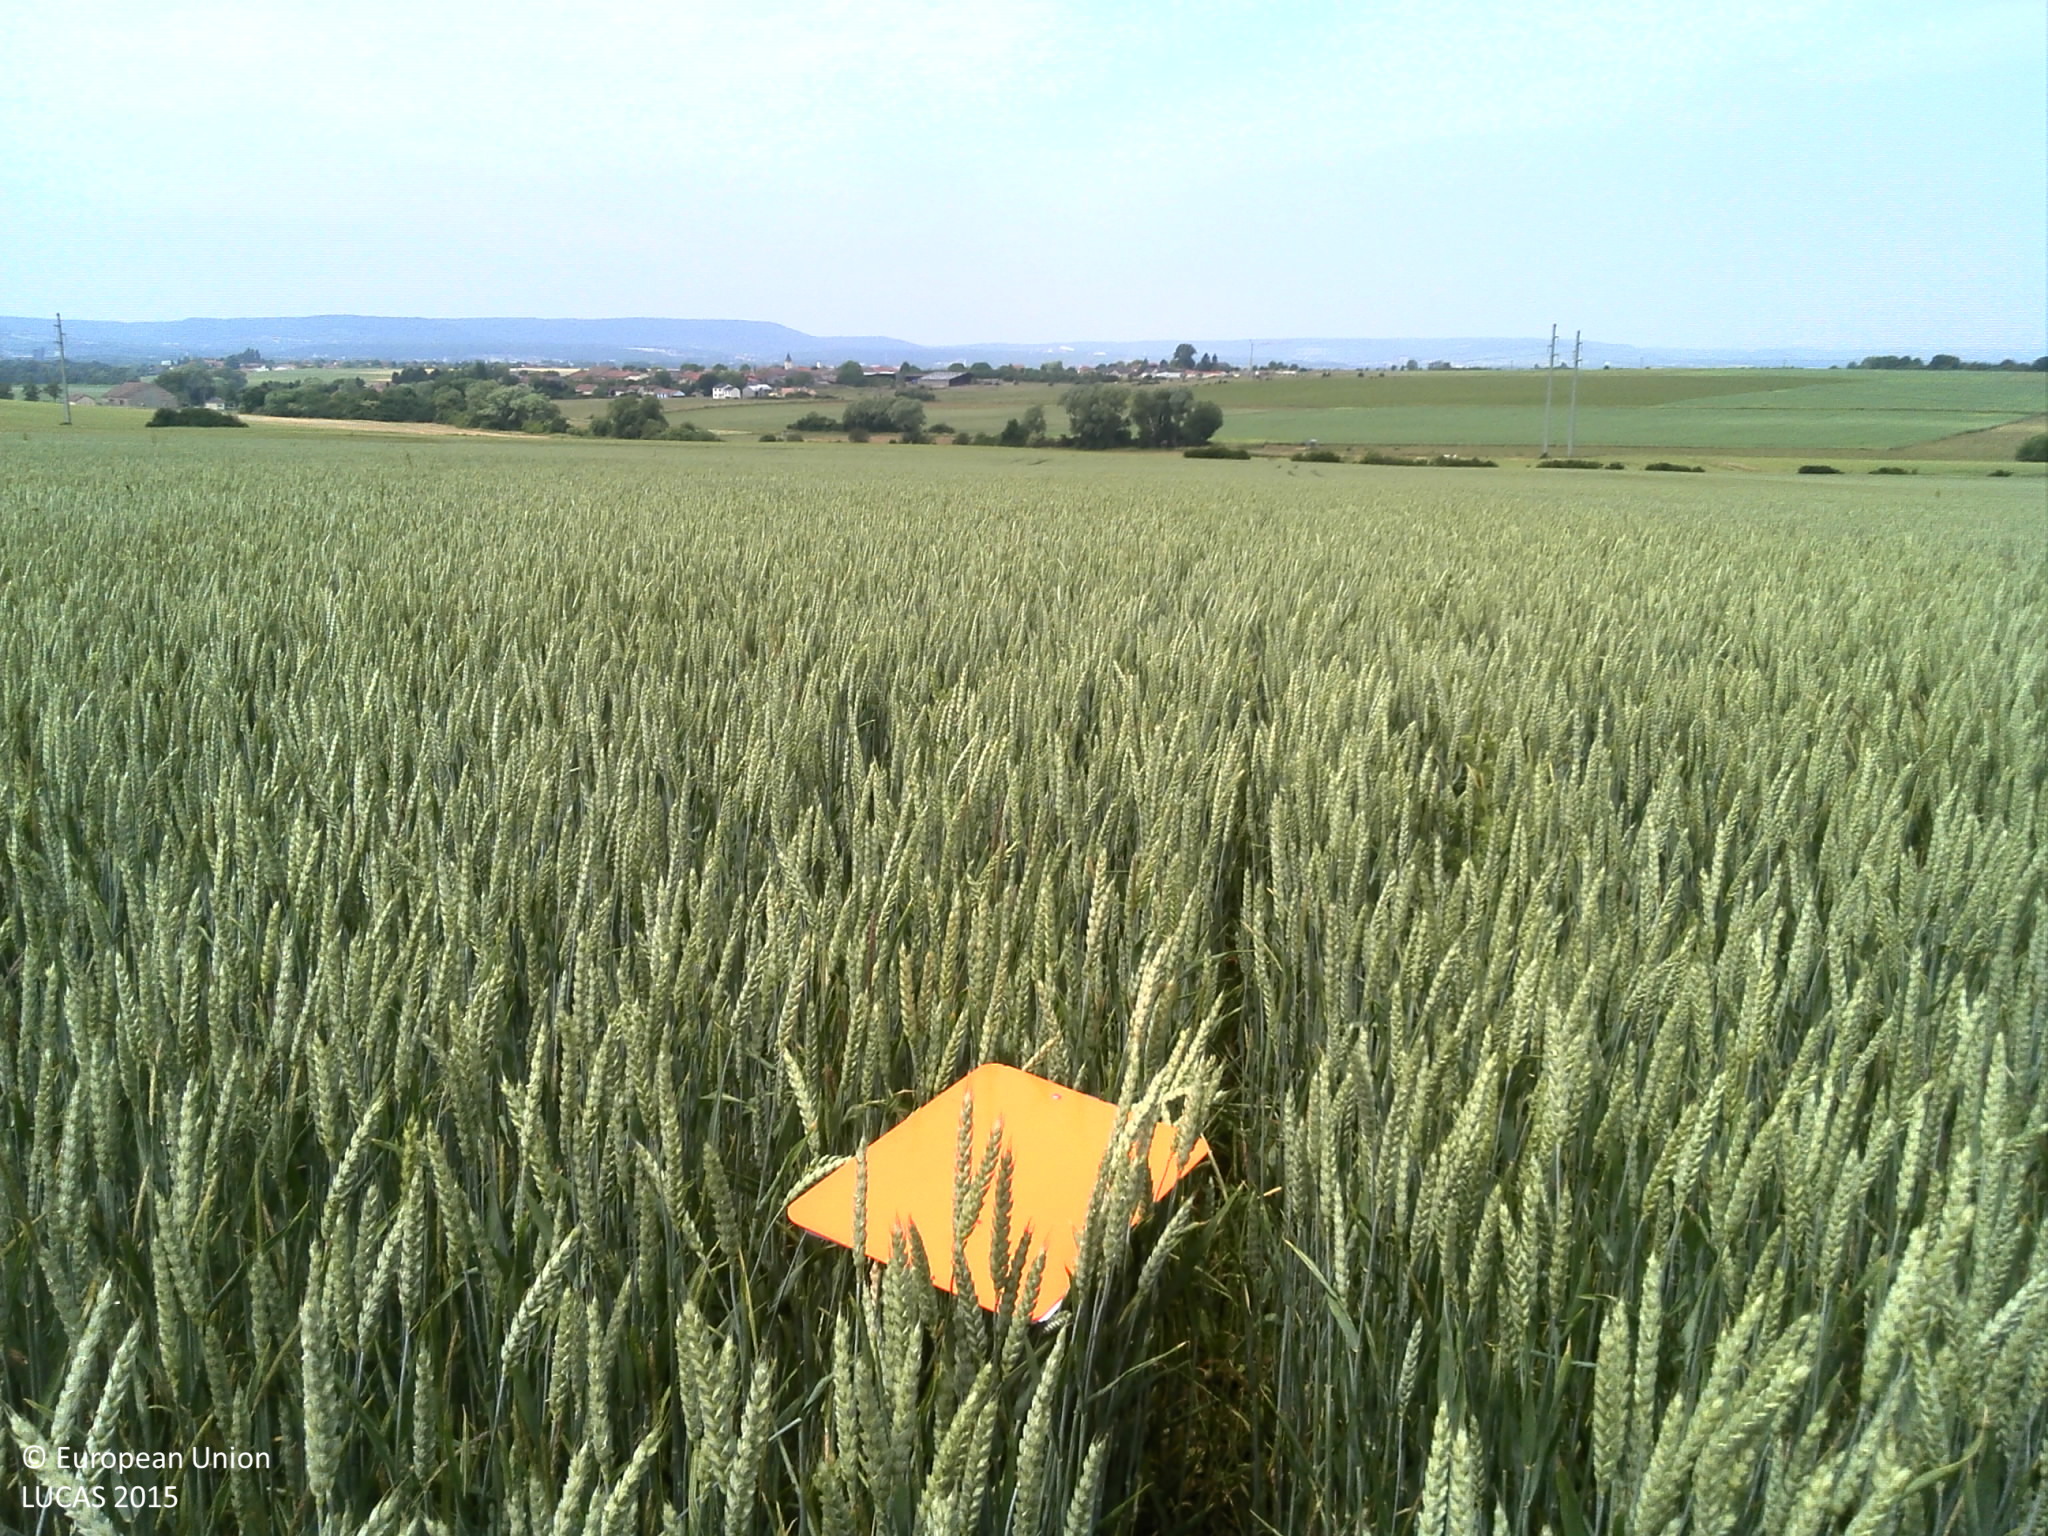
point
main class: Cropland
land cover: Common wheat
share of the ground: > 75 %
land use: Agriculture (excluding fallow land and kitchen gardens)
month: June
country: FR
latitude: 49.2045
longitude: 6.2527
